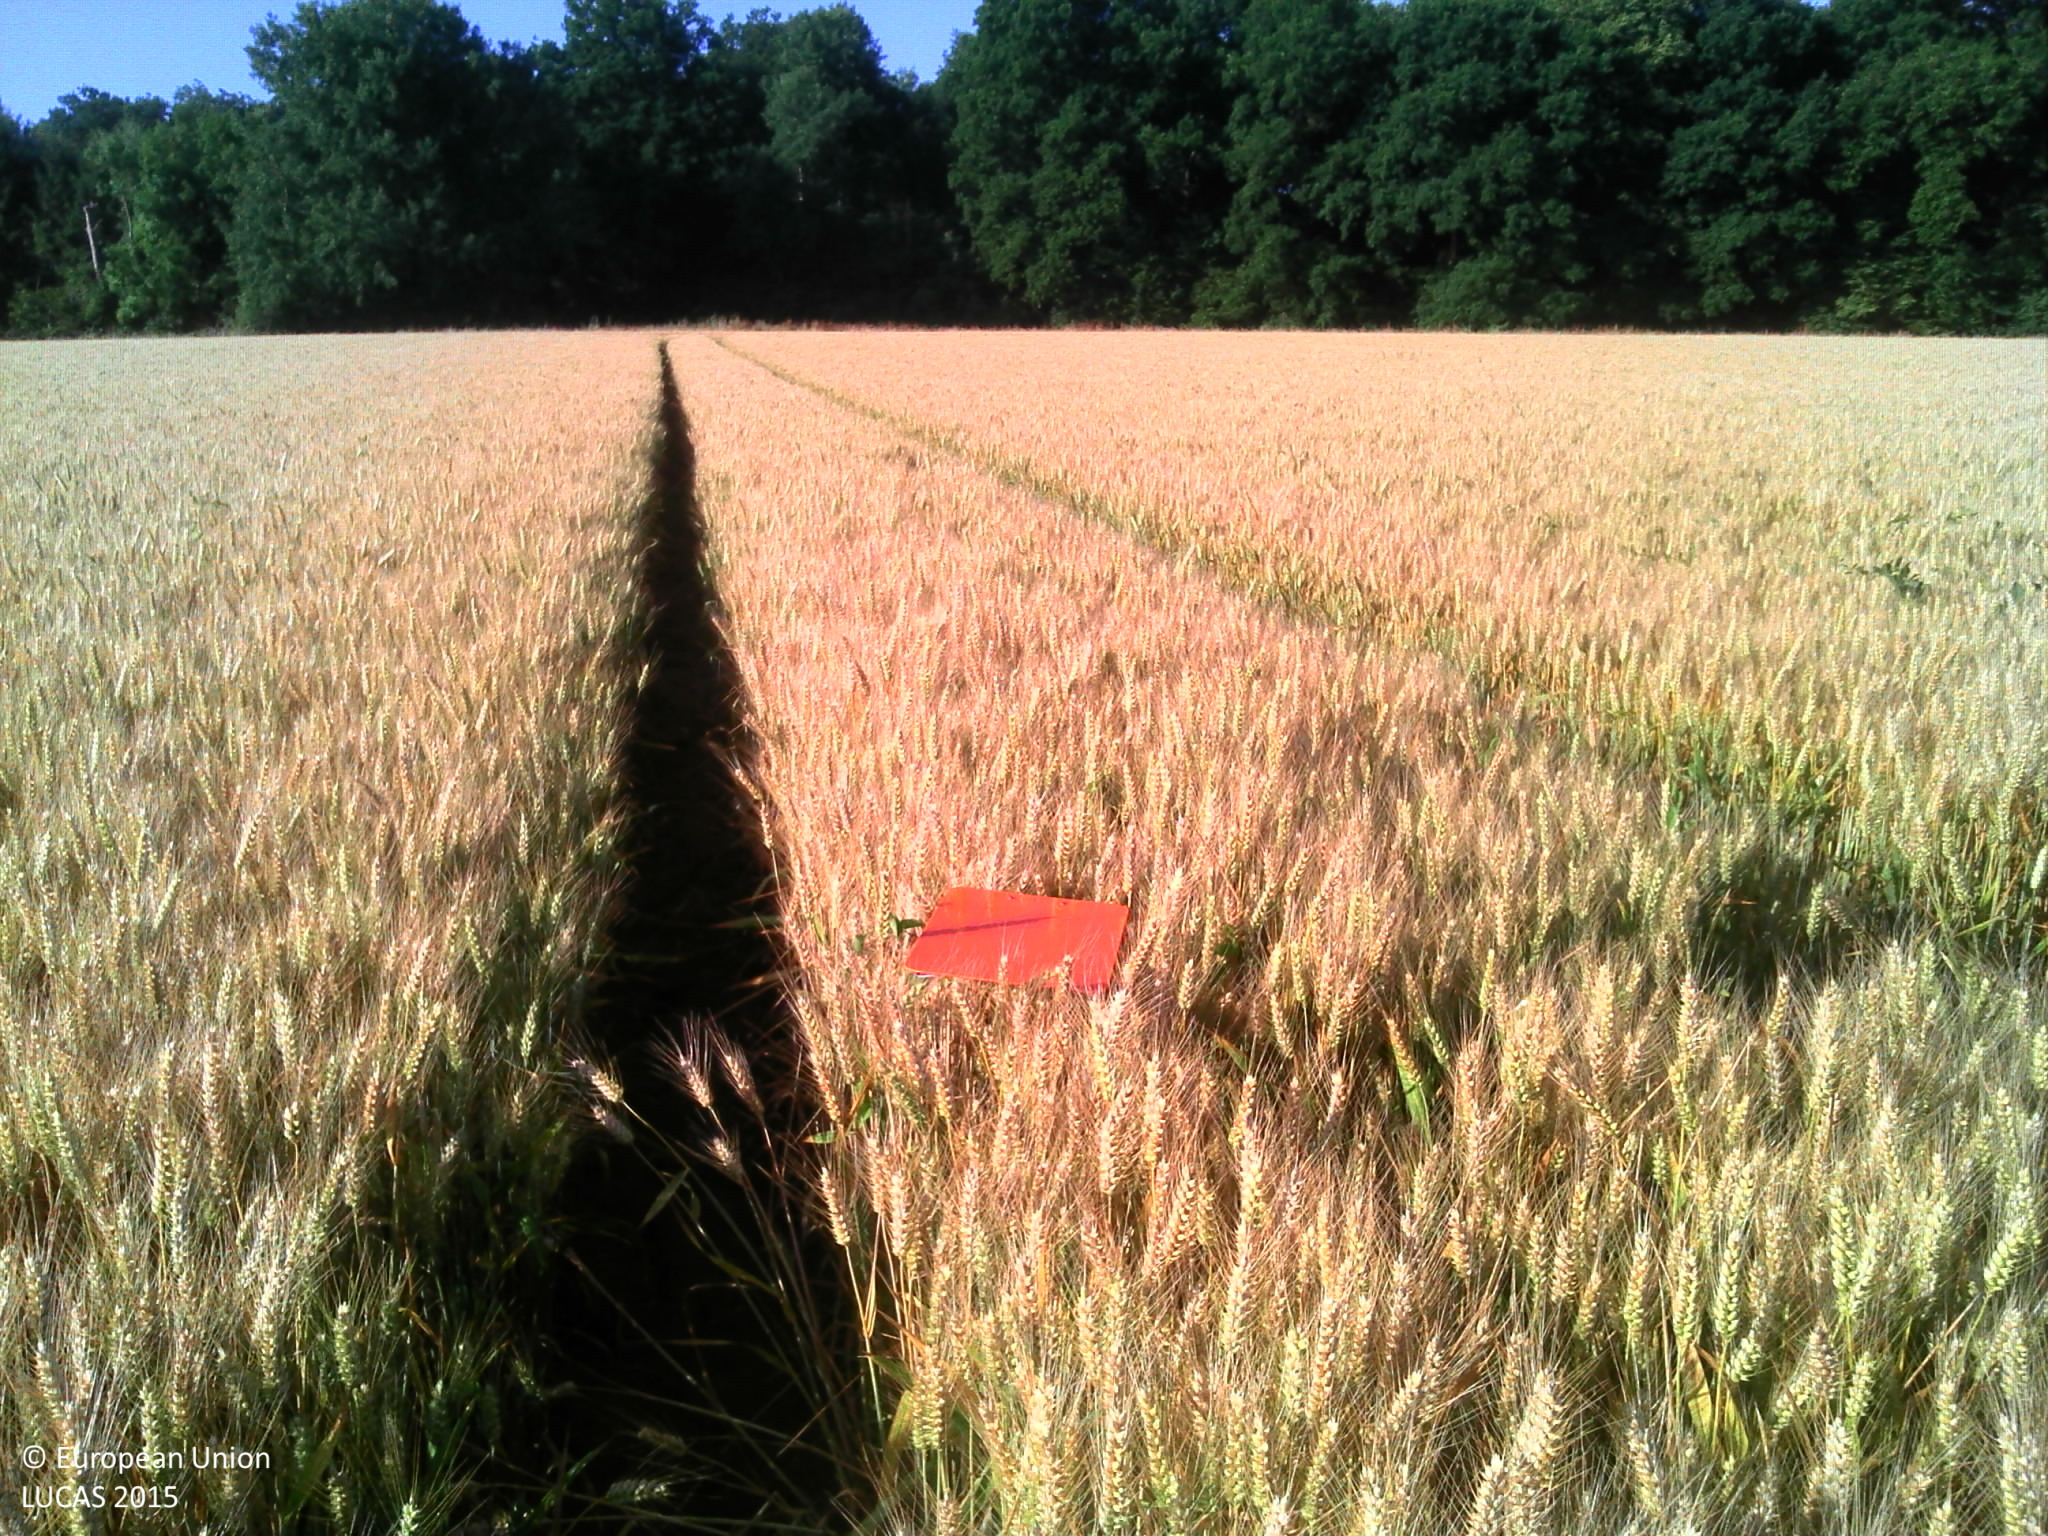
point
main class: Cropland
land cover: Common wheat
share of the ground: > 75 %
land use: Agriculture (excluding fallow land and kitchen gardens)
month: July
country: FR
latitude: 49.0591
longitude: 0.0480
